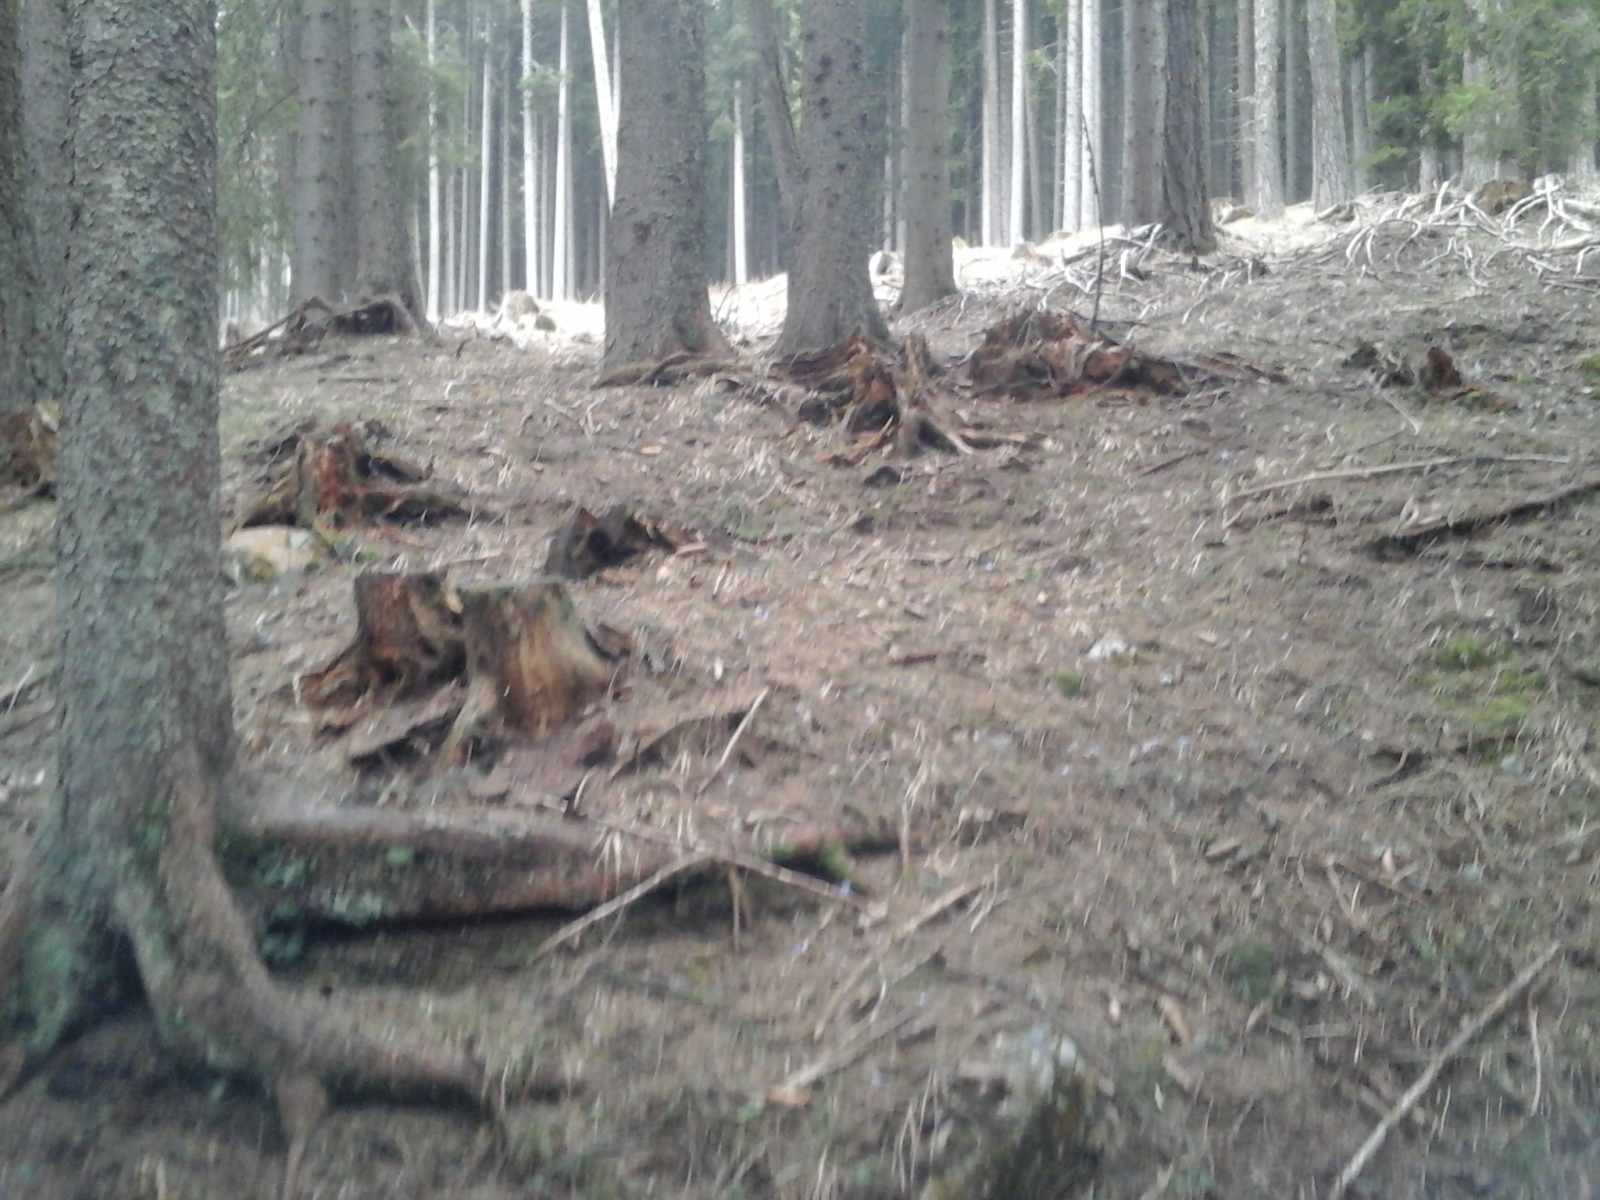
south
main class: Woodland
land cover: Spruce dominated coniferous woodland
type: alpine coniferous forest
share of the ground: > 75 %
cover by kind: coniferous forest trees 95 %, herbaceous plants 5 %
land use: Forestry
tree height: > 5 m
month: May
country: IT
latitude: 46.3929
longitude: 11.6236
